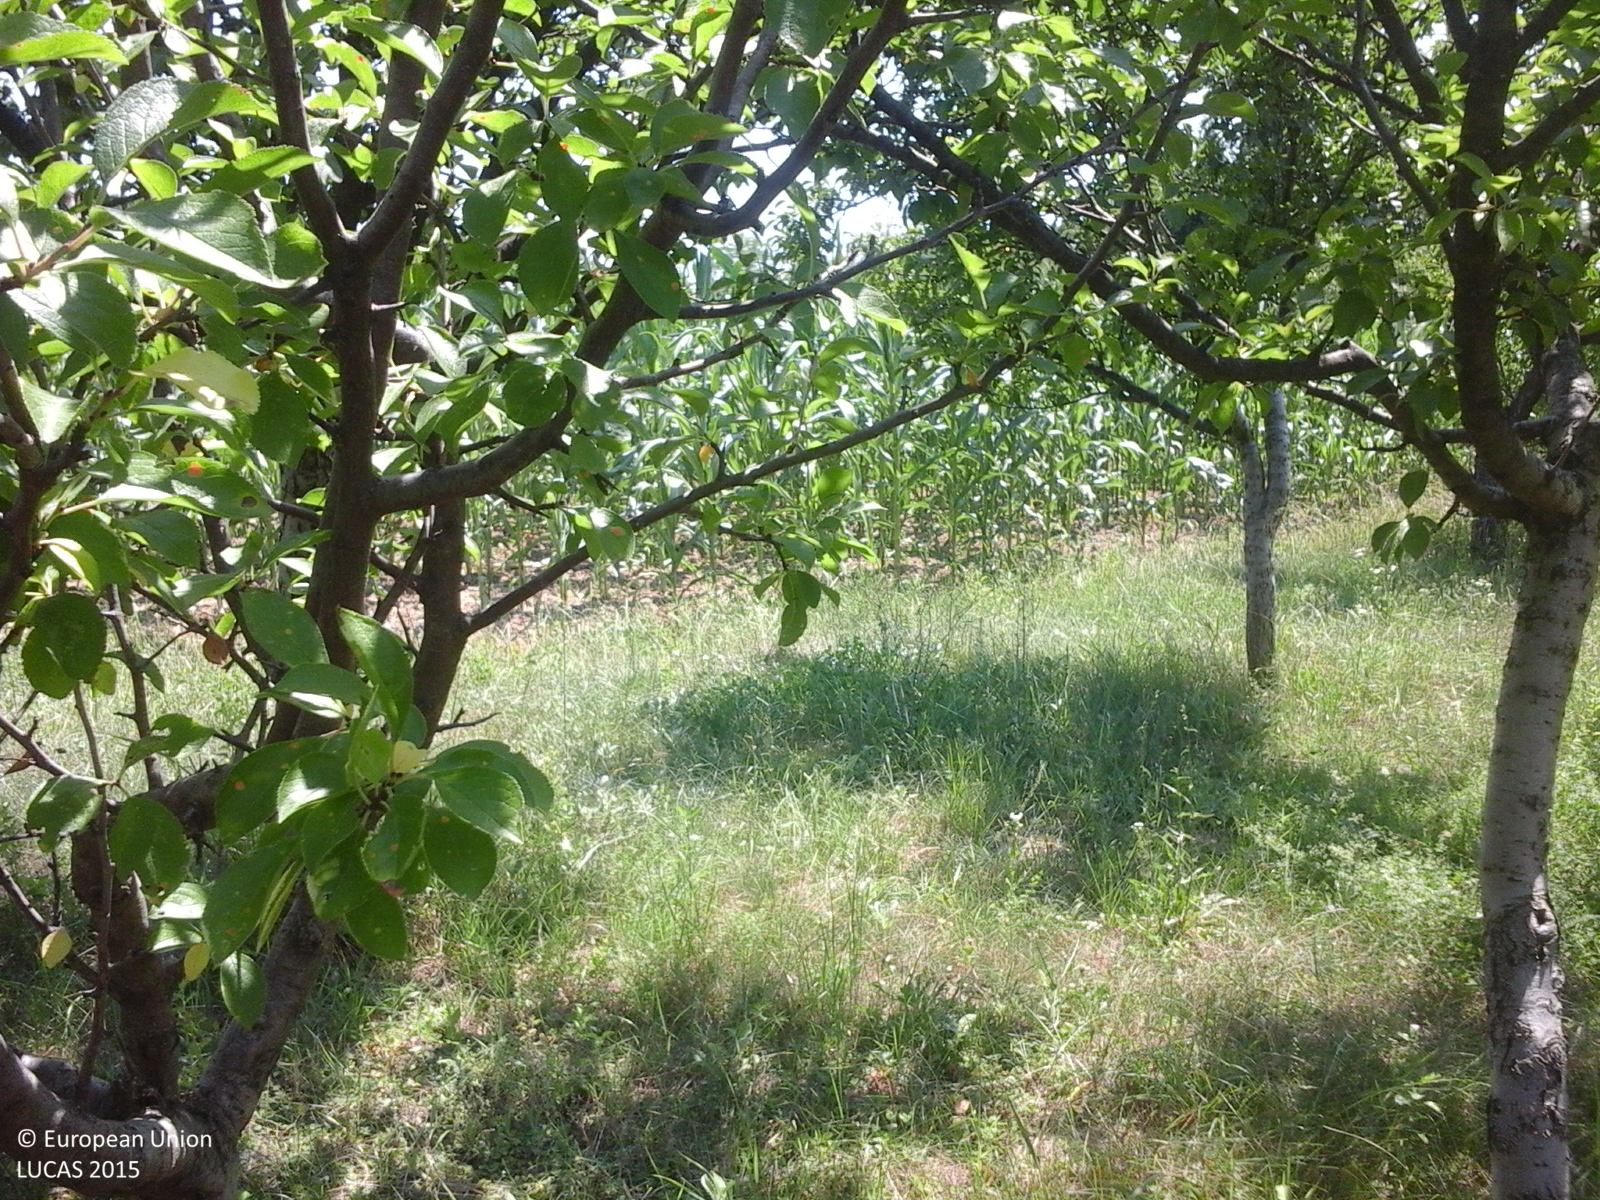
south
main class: Cropland
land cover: Other fruit trees and berries
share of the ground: > 75 %
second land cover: Grassland without tree/shrub cover
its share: > 75 %
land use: Agriculture (excluding fallow land and kitchen gardens)
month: July
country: RO
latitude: 44.8081
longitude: 24.6292
